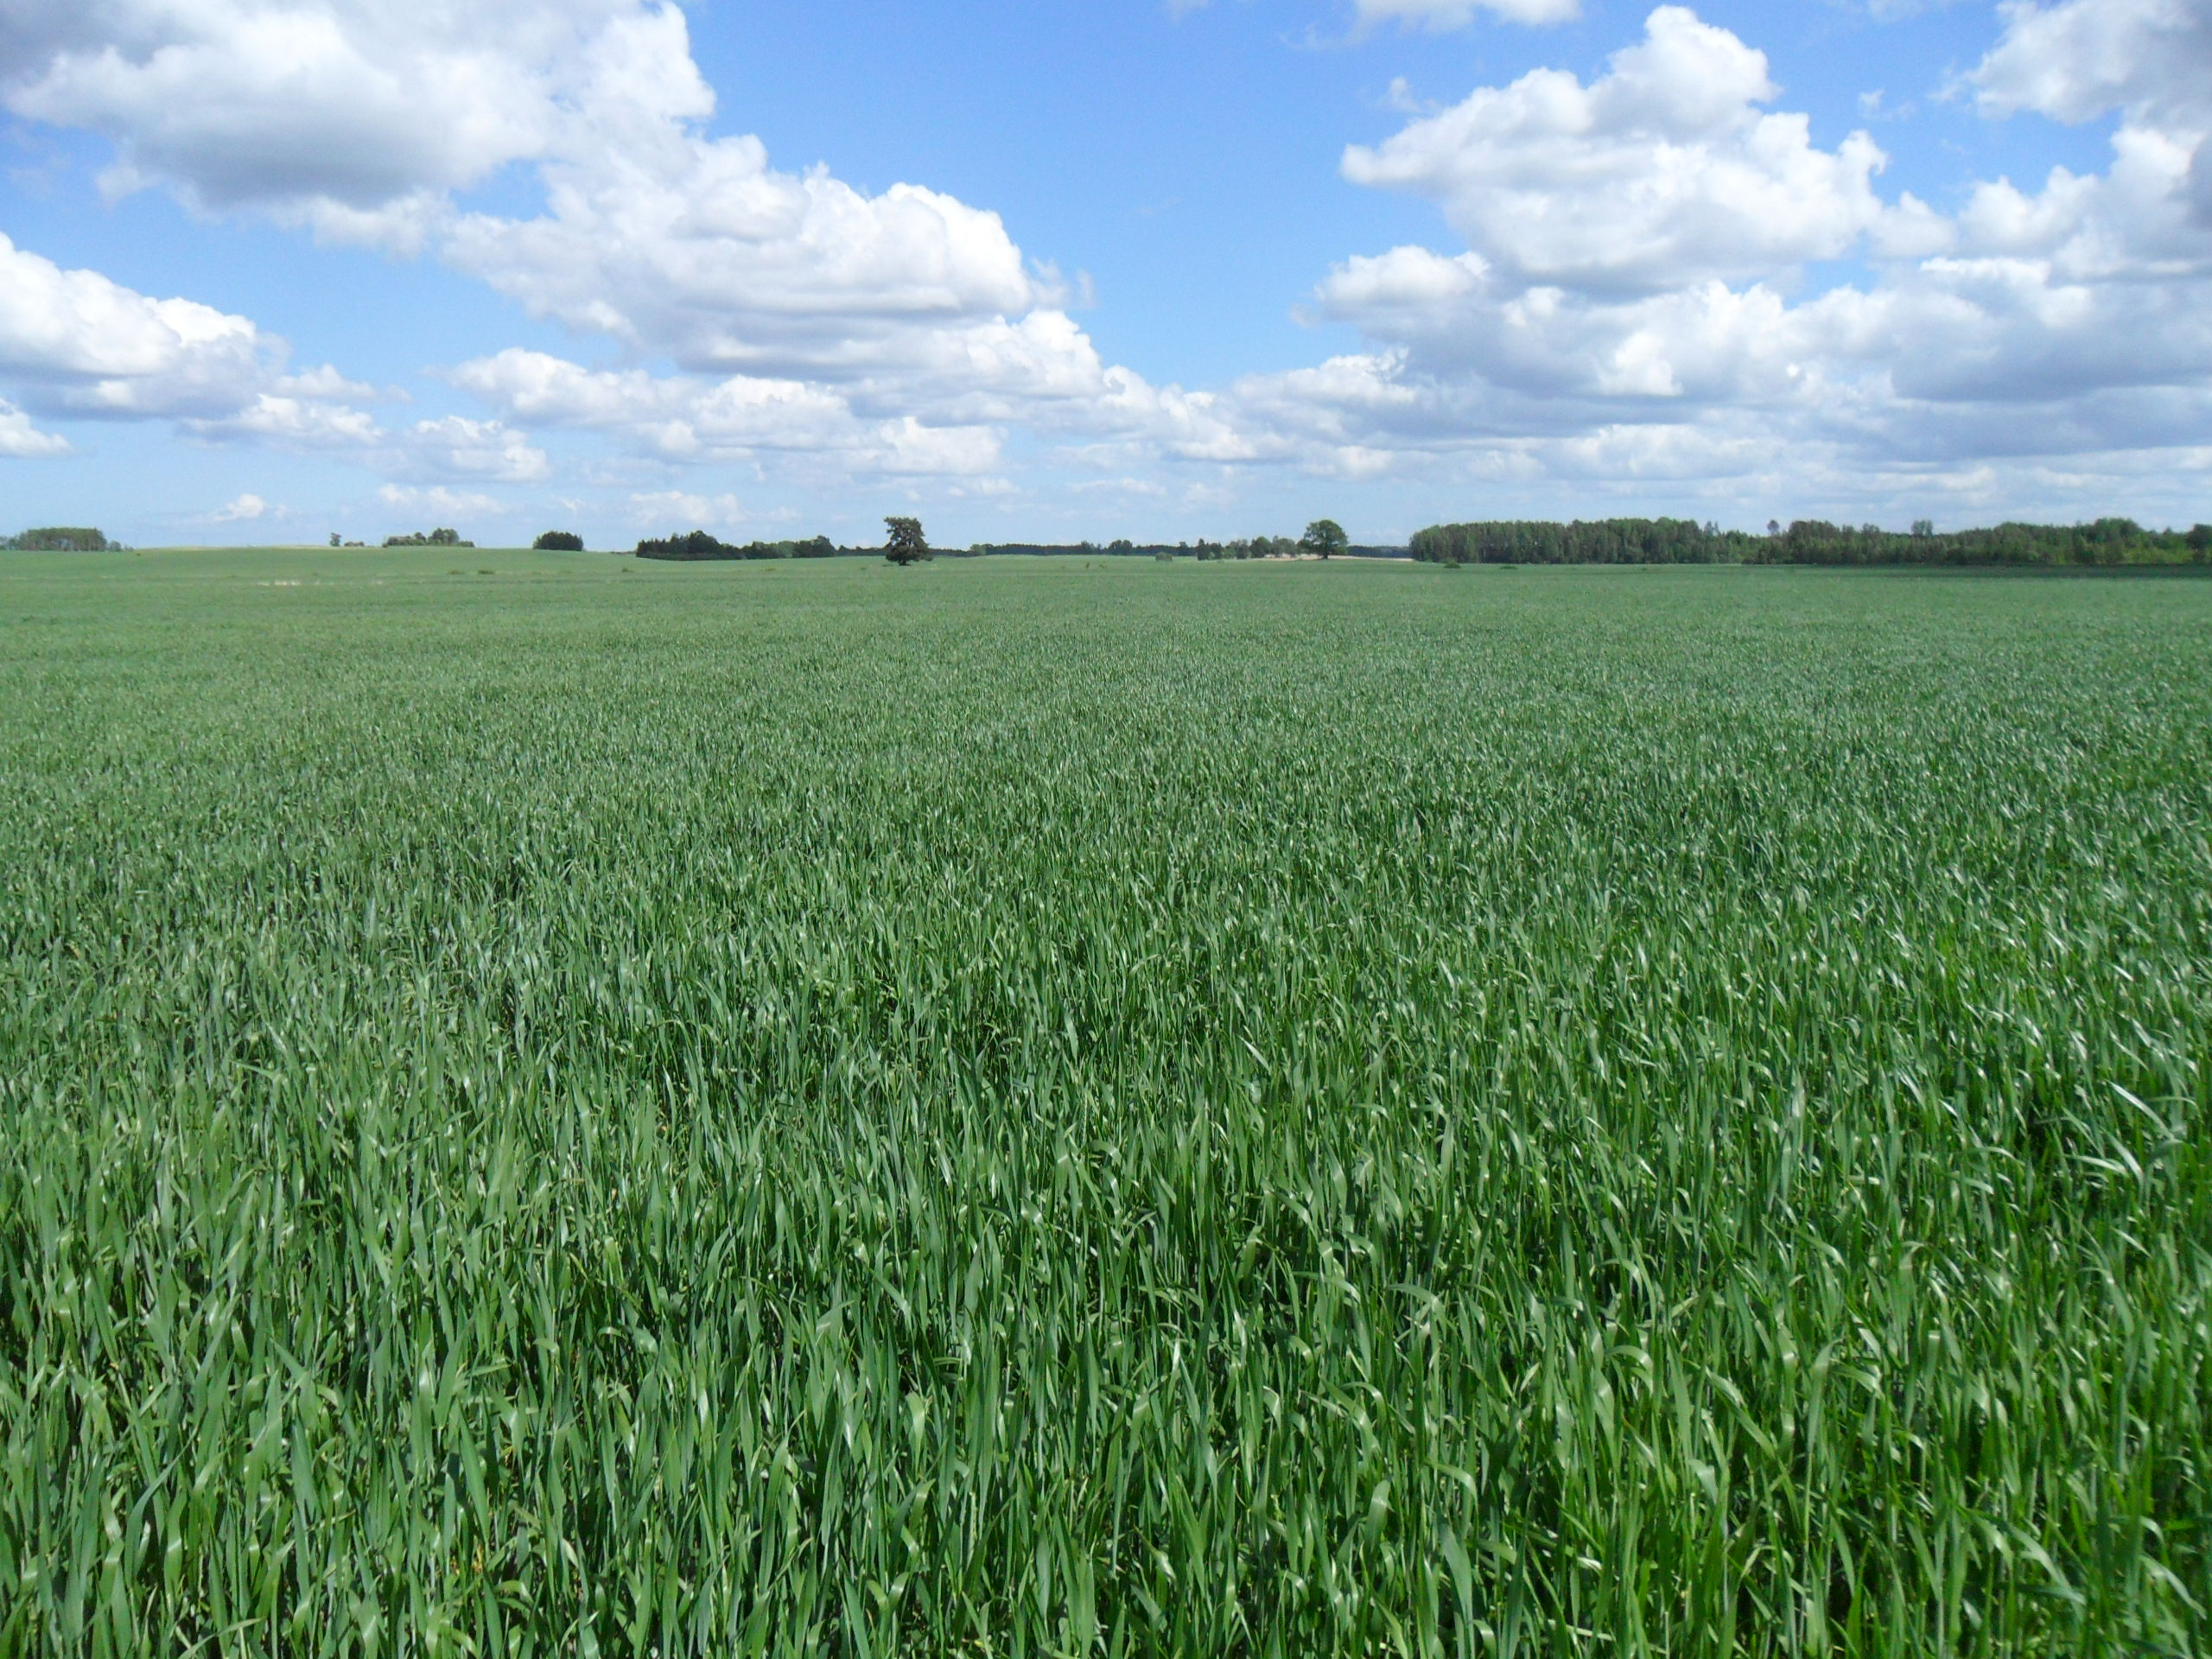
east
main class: Cropland
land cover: Common wheat
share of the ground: > 75 %
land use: Agriculture (excluding fallow land and kitchen gardens)
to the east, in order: Common wheat; Grass margins; Ditches and canals; Shruby margins; Common wheat
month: June
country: LV
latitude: 57.0755
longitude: 22.9794
